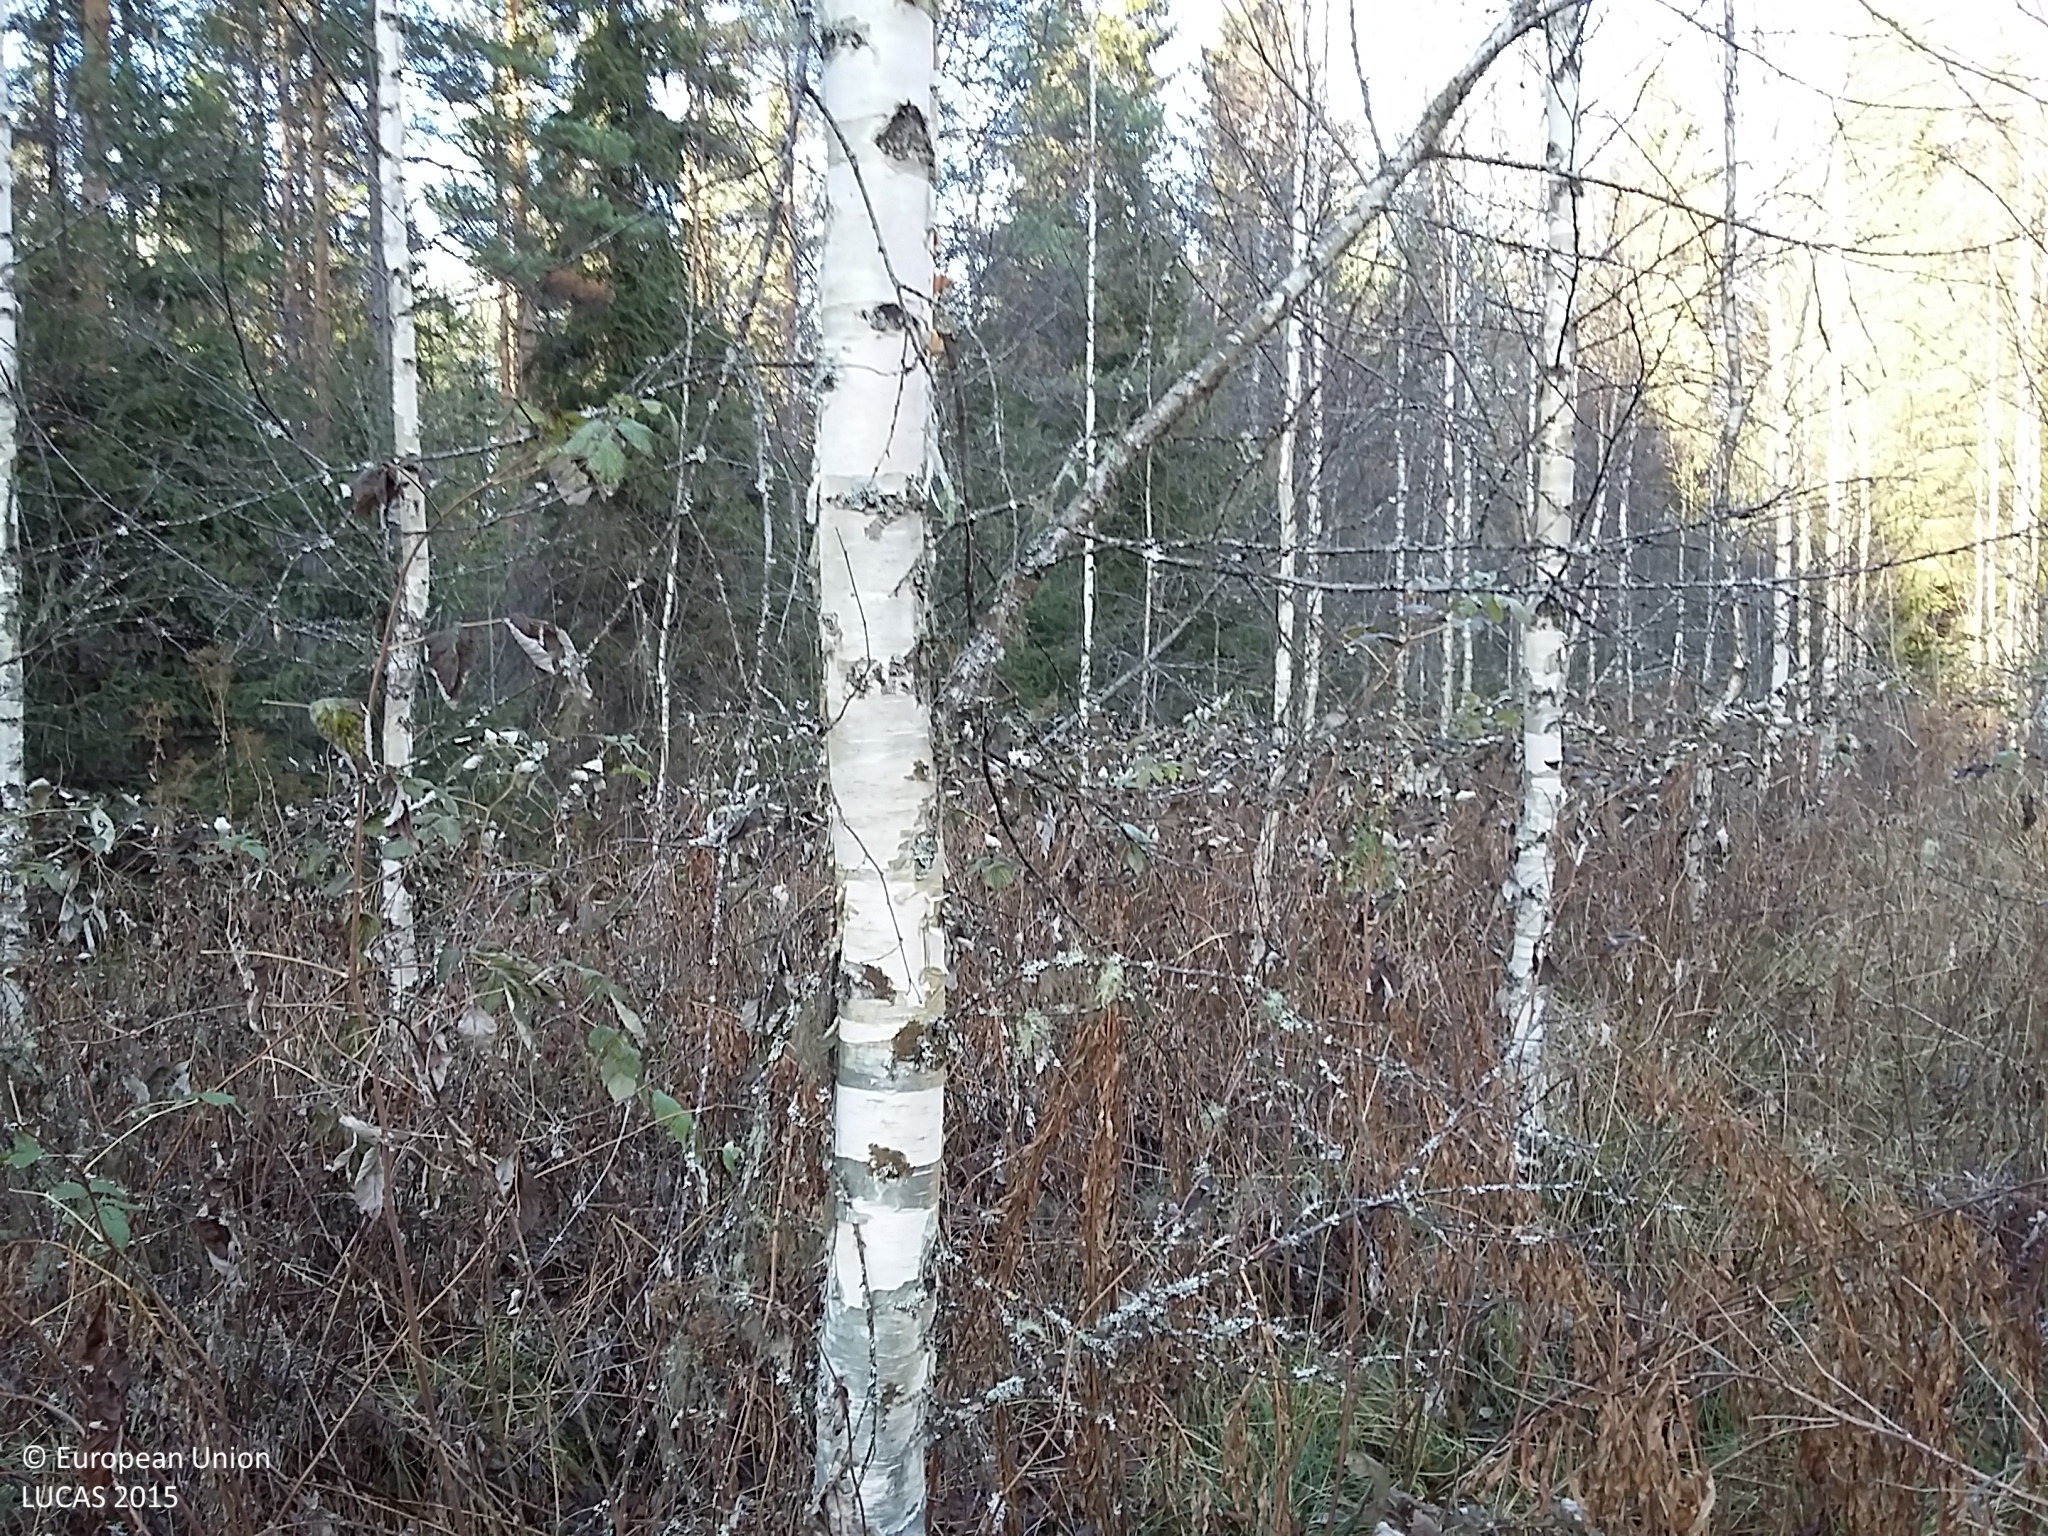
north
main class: Woodland
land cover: Broadleaved woodland
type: non-riverine alder, birch or aspen forest
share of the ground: 50 - 75 %
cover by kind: broadleaved forest trees 70 %, shrubs 15 %, herbaceous plants 15 %
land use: Forestry
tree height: > 5 m
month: October
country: FI
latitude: 64.5498
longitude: 25.5450
